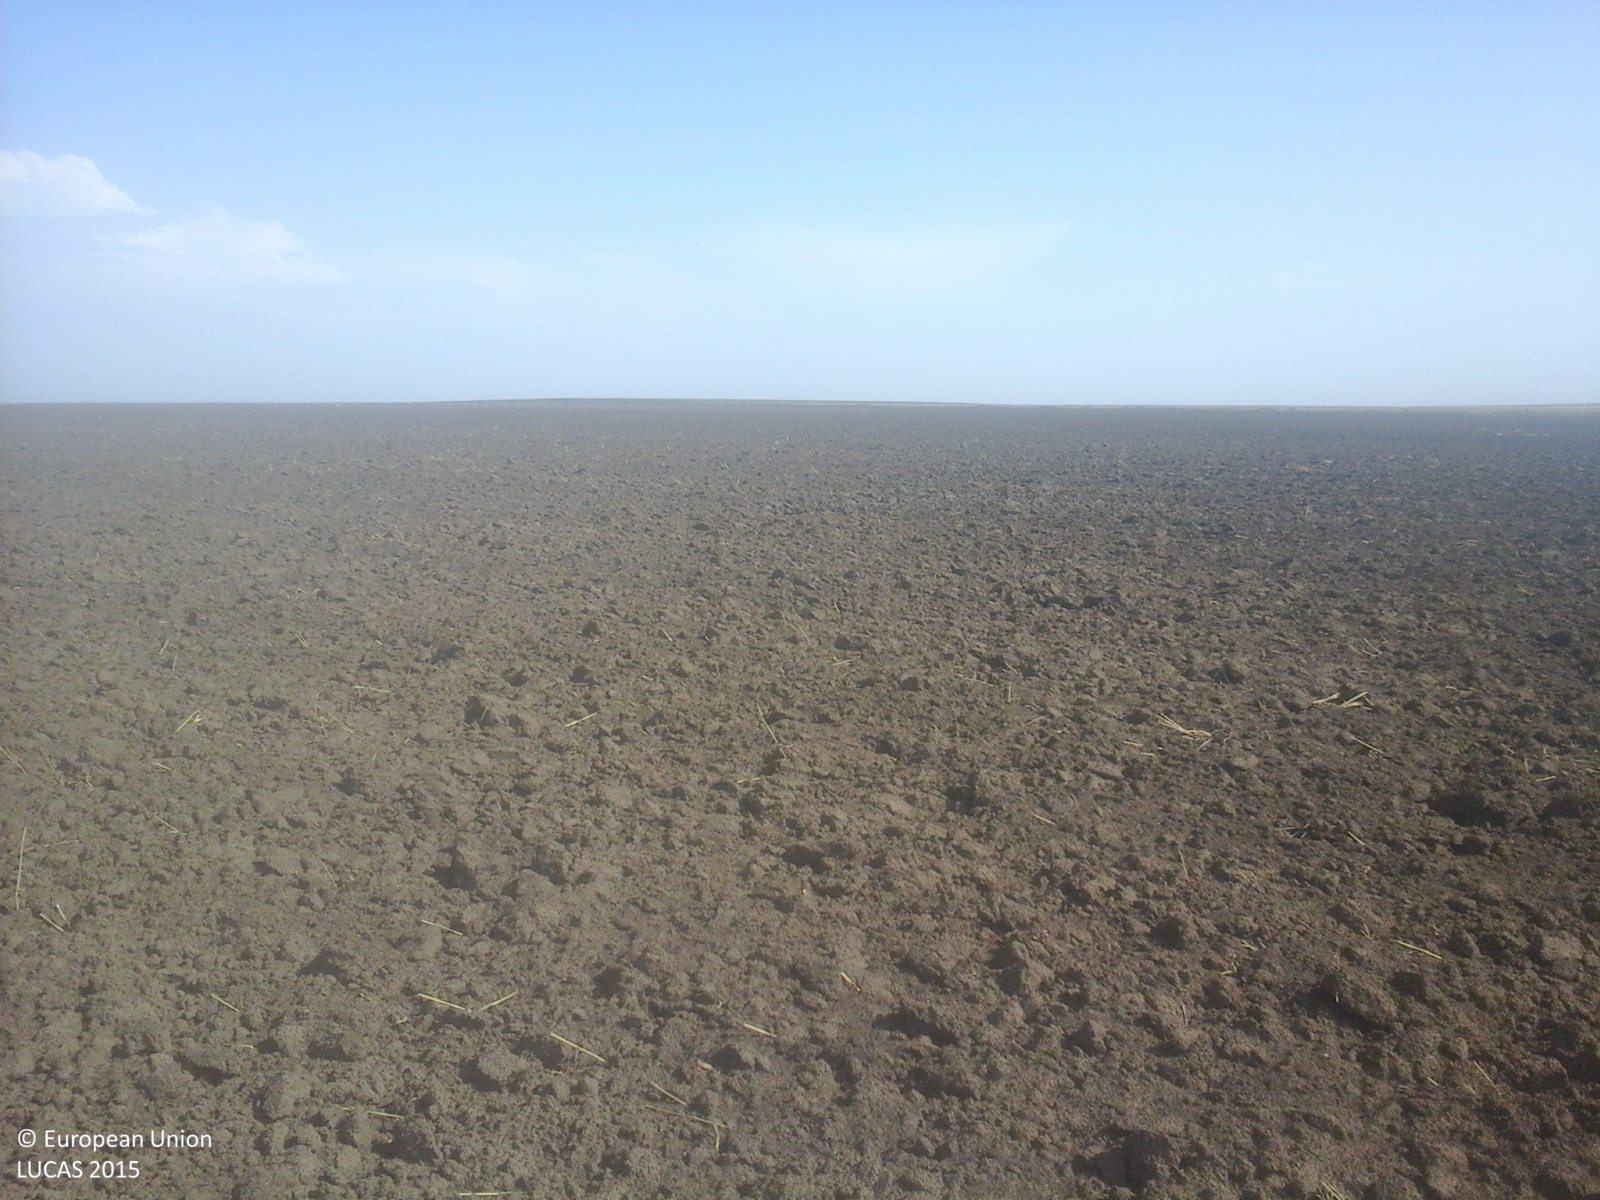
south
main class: Cropland
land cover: Common wheat
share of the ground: < 10 %
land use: Agriculture (excluding fallow land and kitchen gardens)
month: August
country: RO
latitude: 43.9536
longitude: 28.2398
